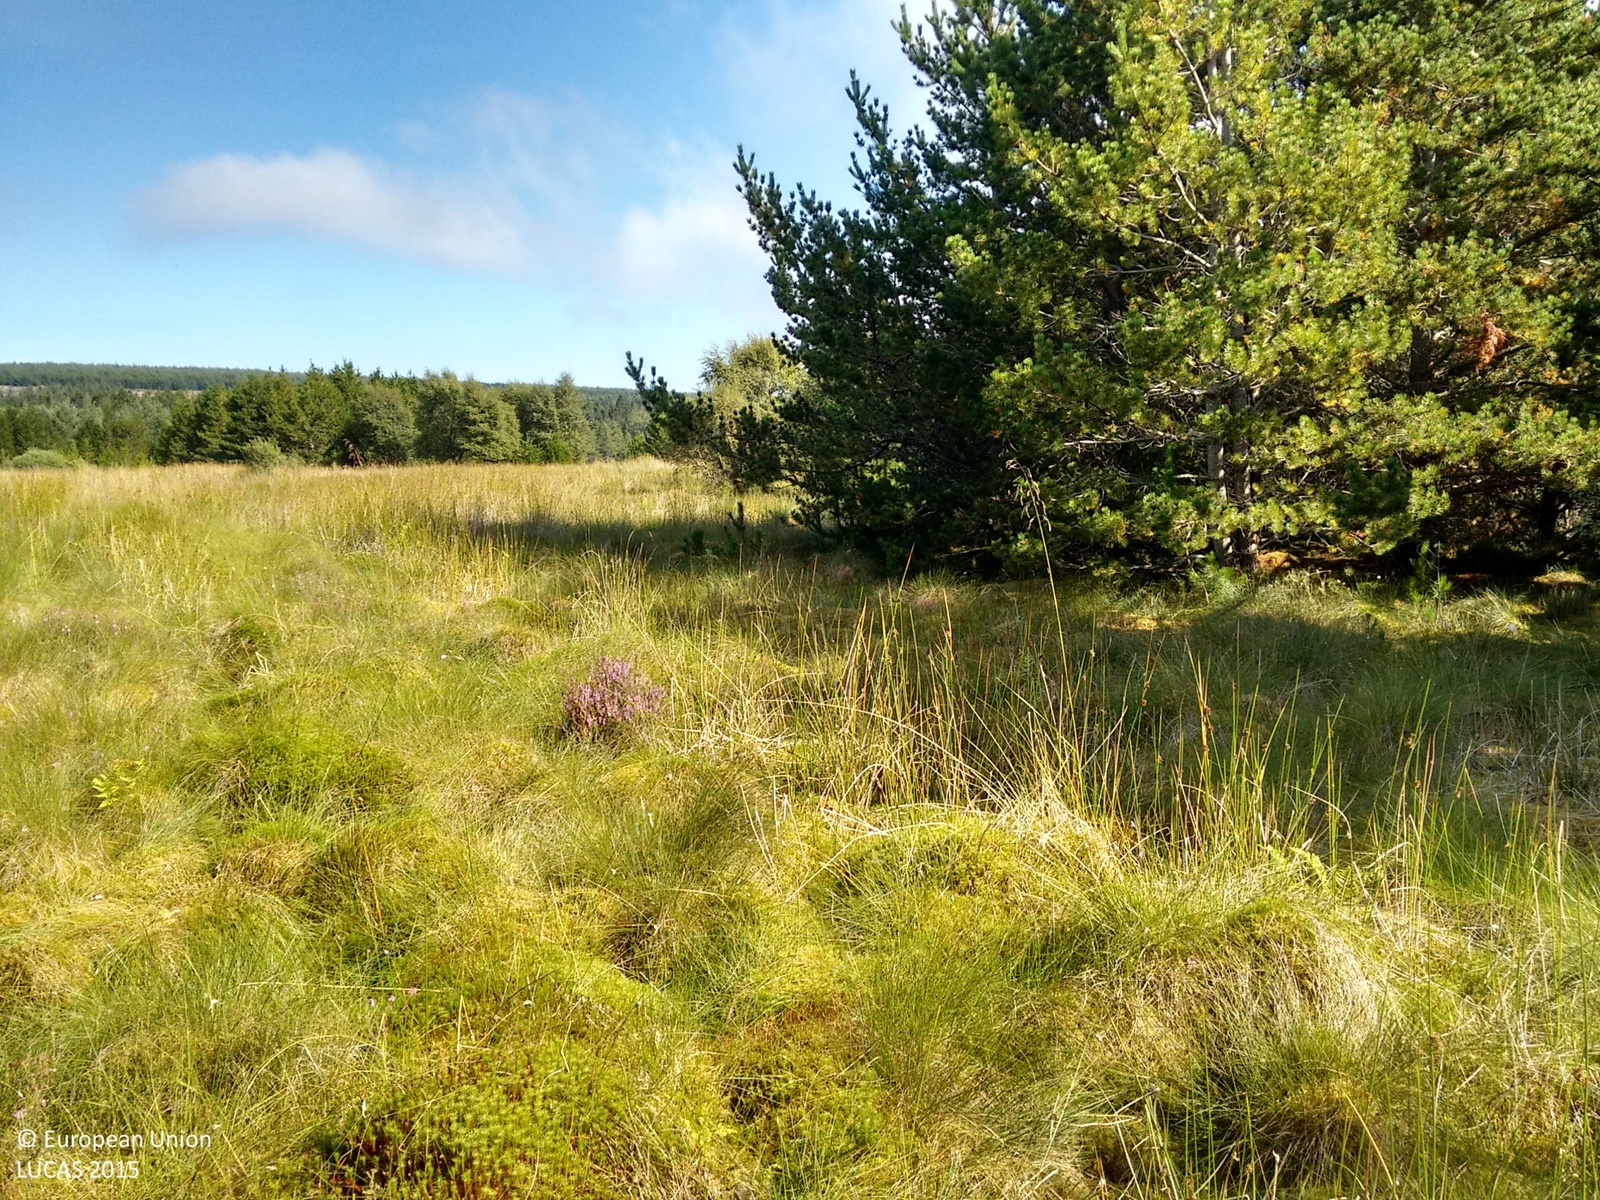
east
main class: Woodland
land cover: Pine dominated mixed woodland
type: exotic forest
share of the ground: > 75 %
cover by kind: coniferous forest trees 45 %, herbaceous plants 30 %, broadleaved forest trees 15 %, lichens and mosses 10 %
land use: Forestry
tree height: > 5 m
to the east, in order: Pine dominated mixed woodland; Shrubland without tree cover; Shrubland with sparse tree cover; Pine dominated coniferous woodland; Grassland without tree/shrub cover
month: September
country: GB
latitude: 58.0779
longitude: -4.4137
